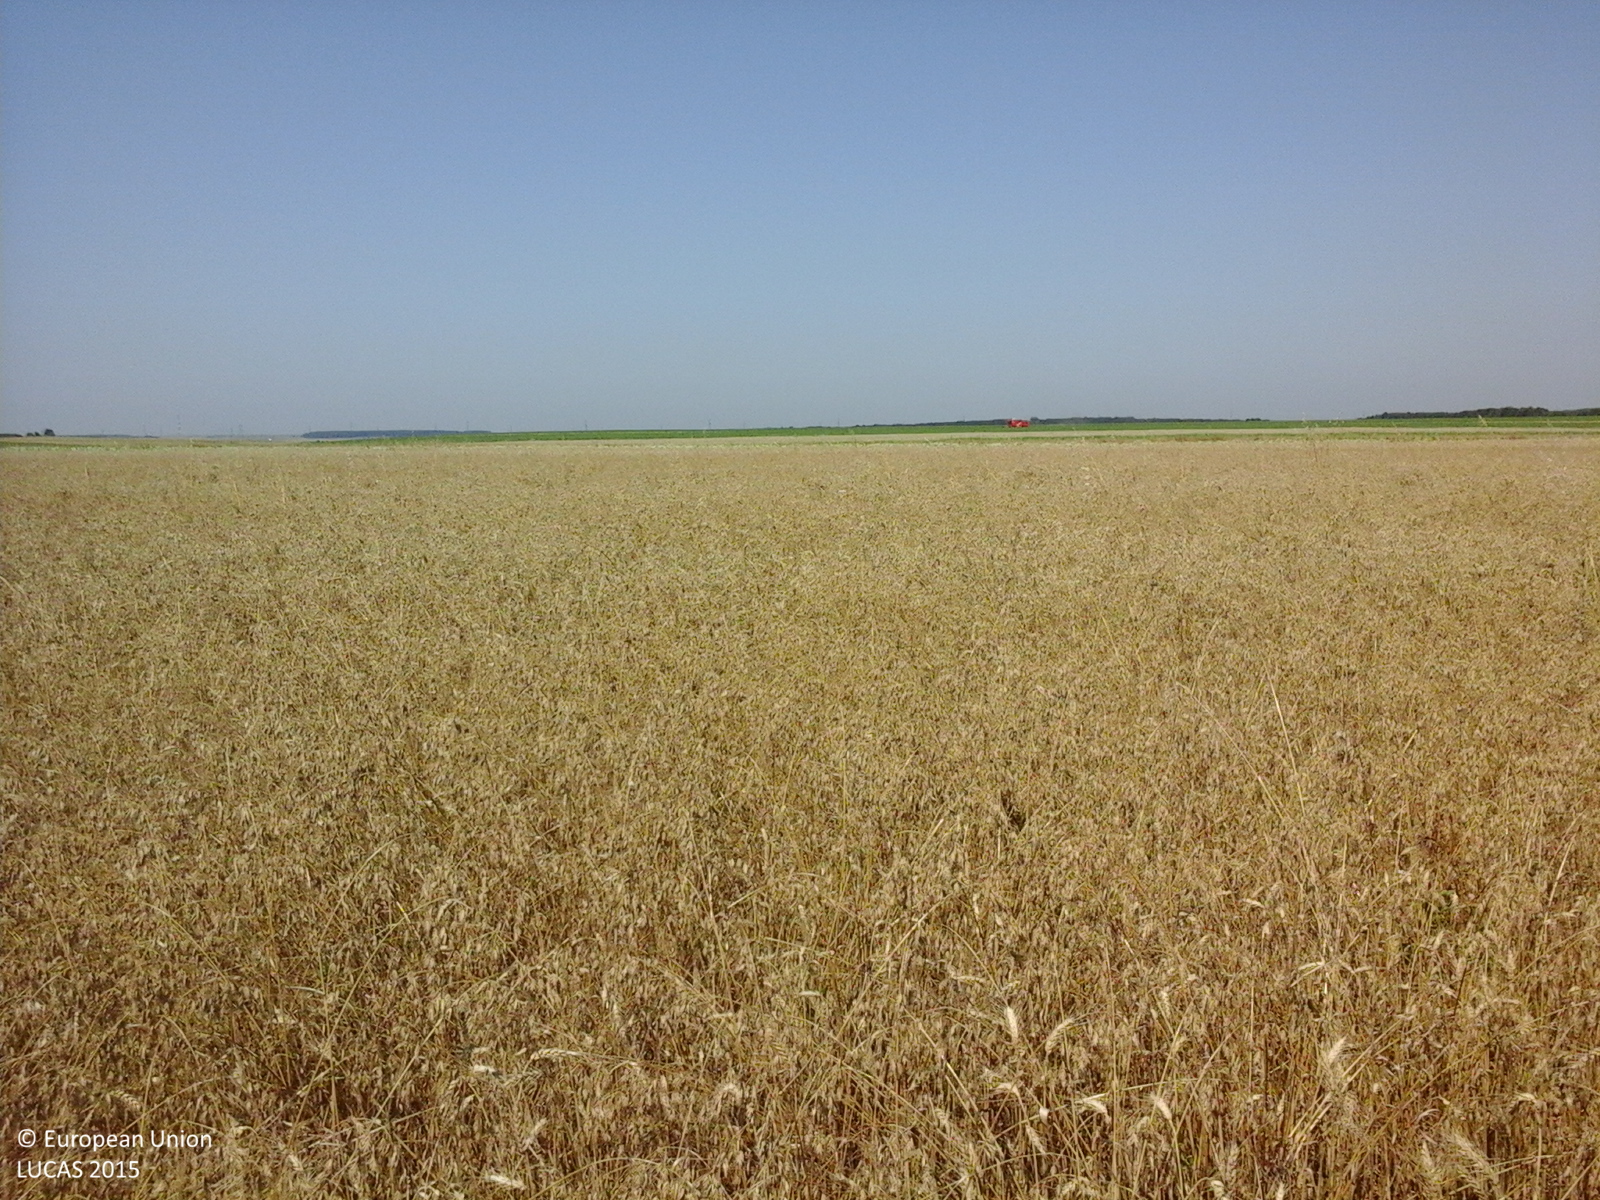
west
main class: Cropland
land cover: Common wheat
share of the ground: > 75 %
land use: Agriculture (excluding fallow land and kitchen gardens)
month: July
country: RO
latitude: 44.3705
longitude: 24.4888
